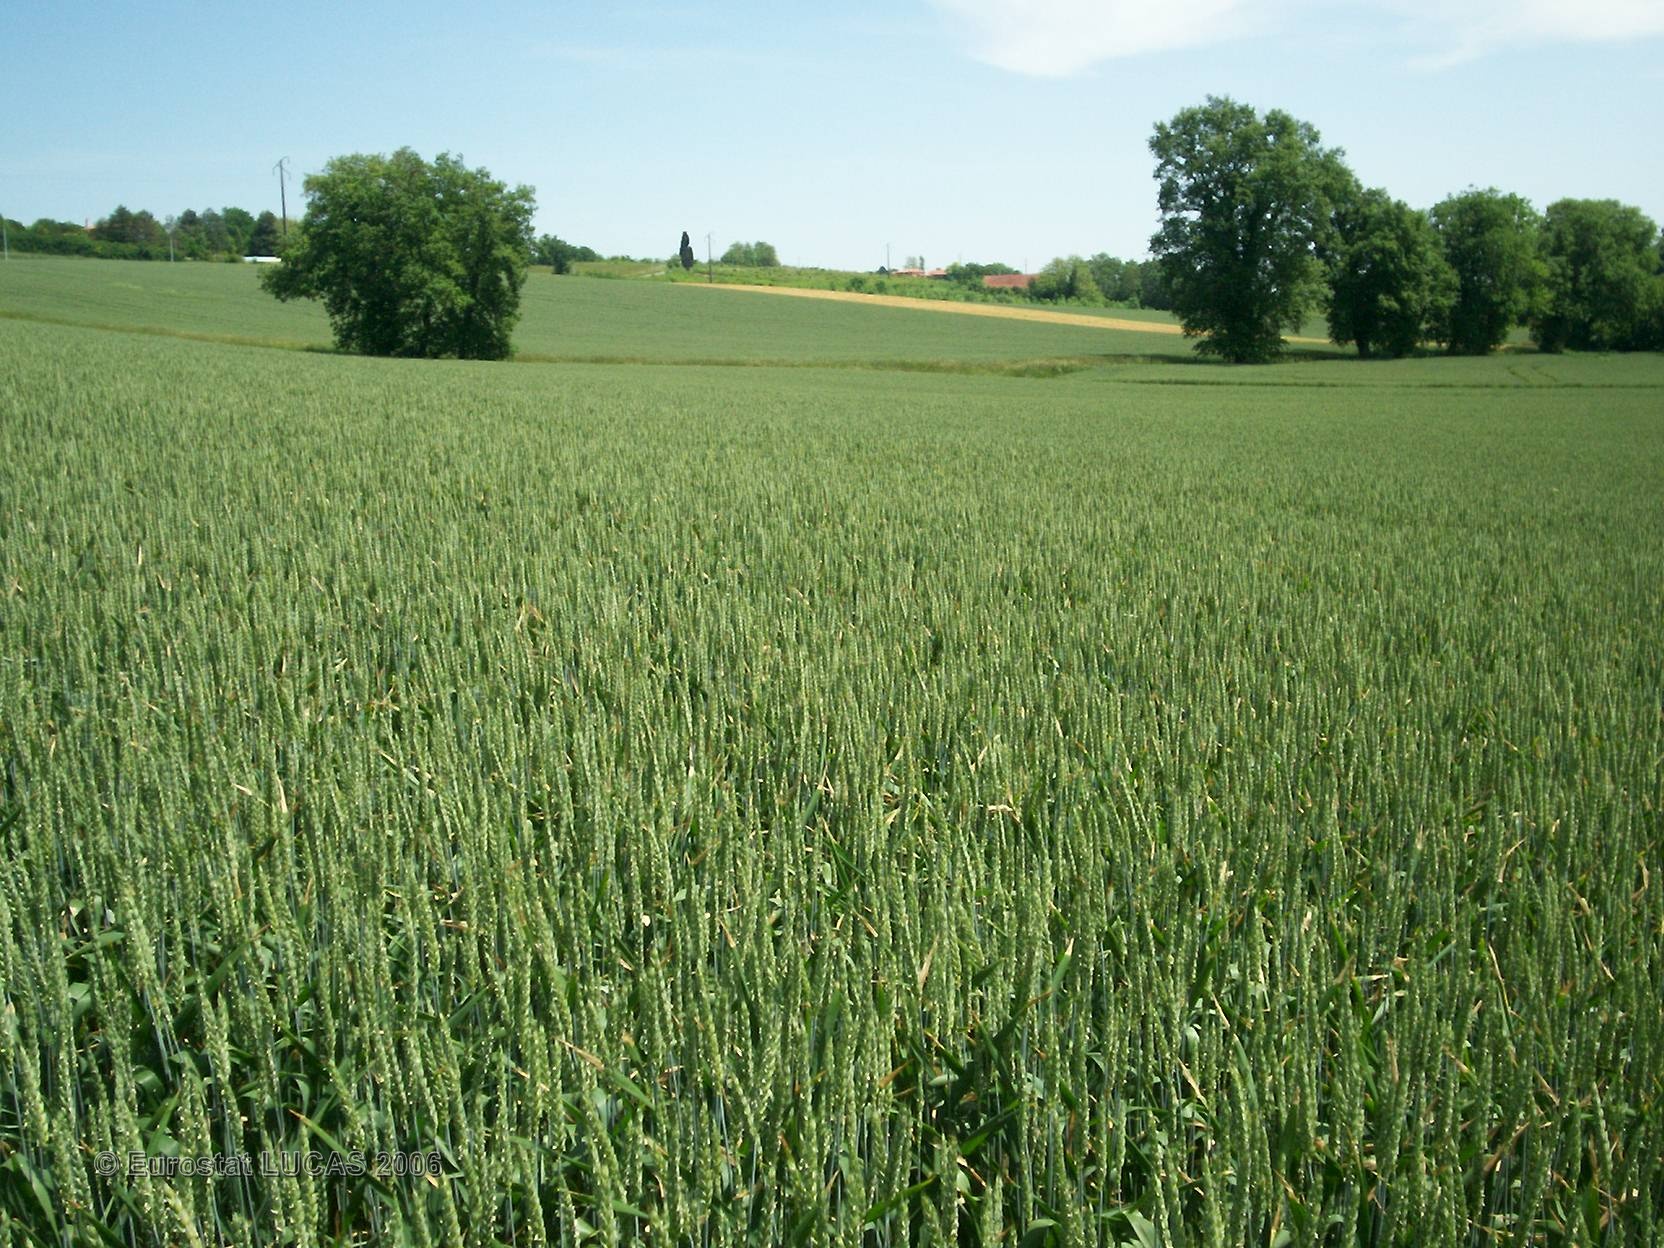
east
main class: Cropland
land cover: Common wheat
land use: Agriculture (excluding fallow land and kitchen gardens)
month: May
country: FR
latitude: 43.6178
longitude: 1.0414
